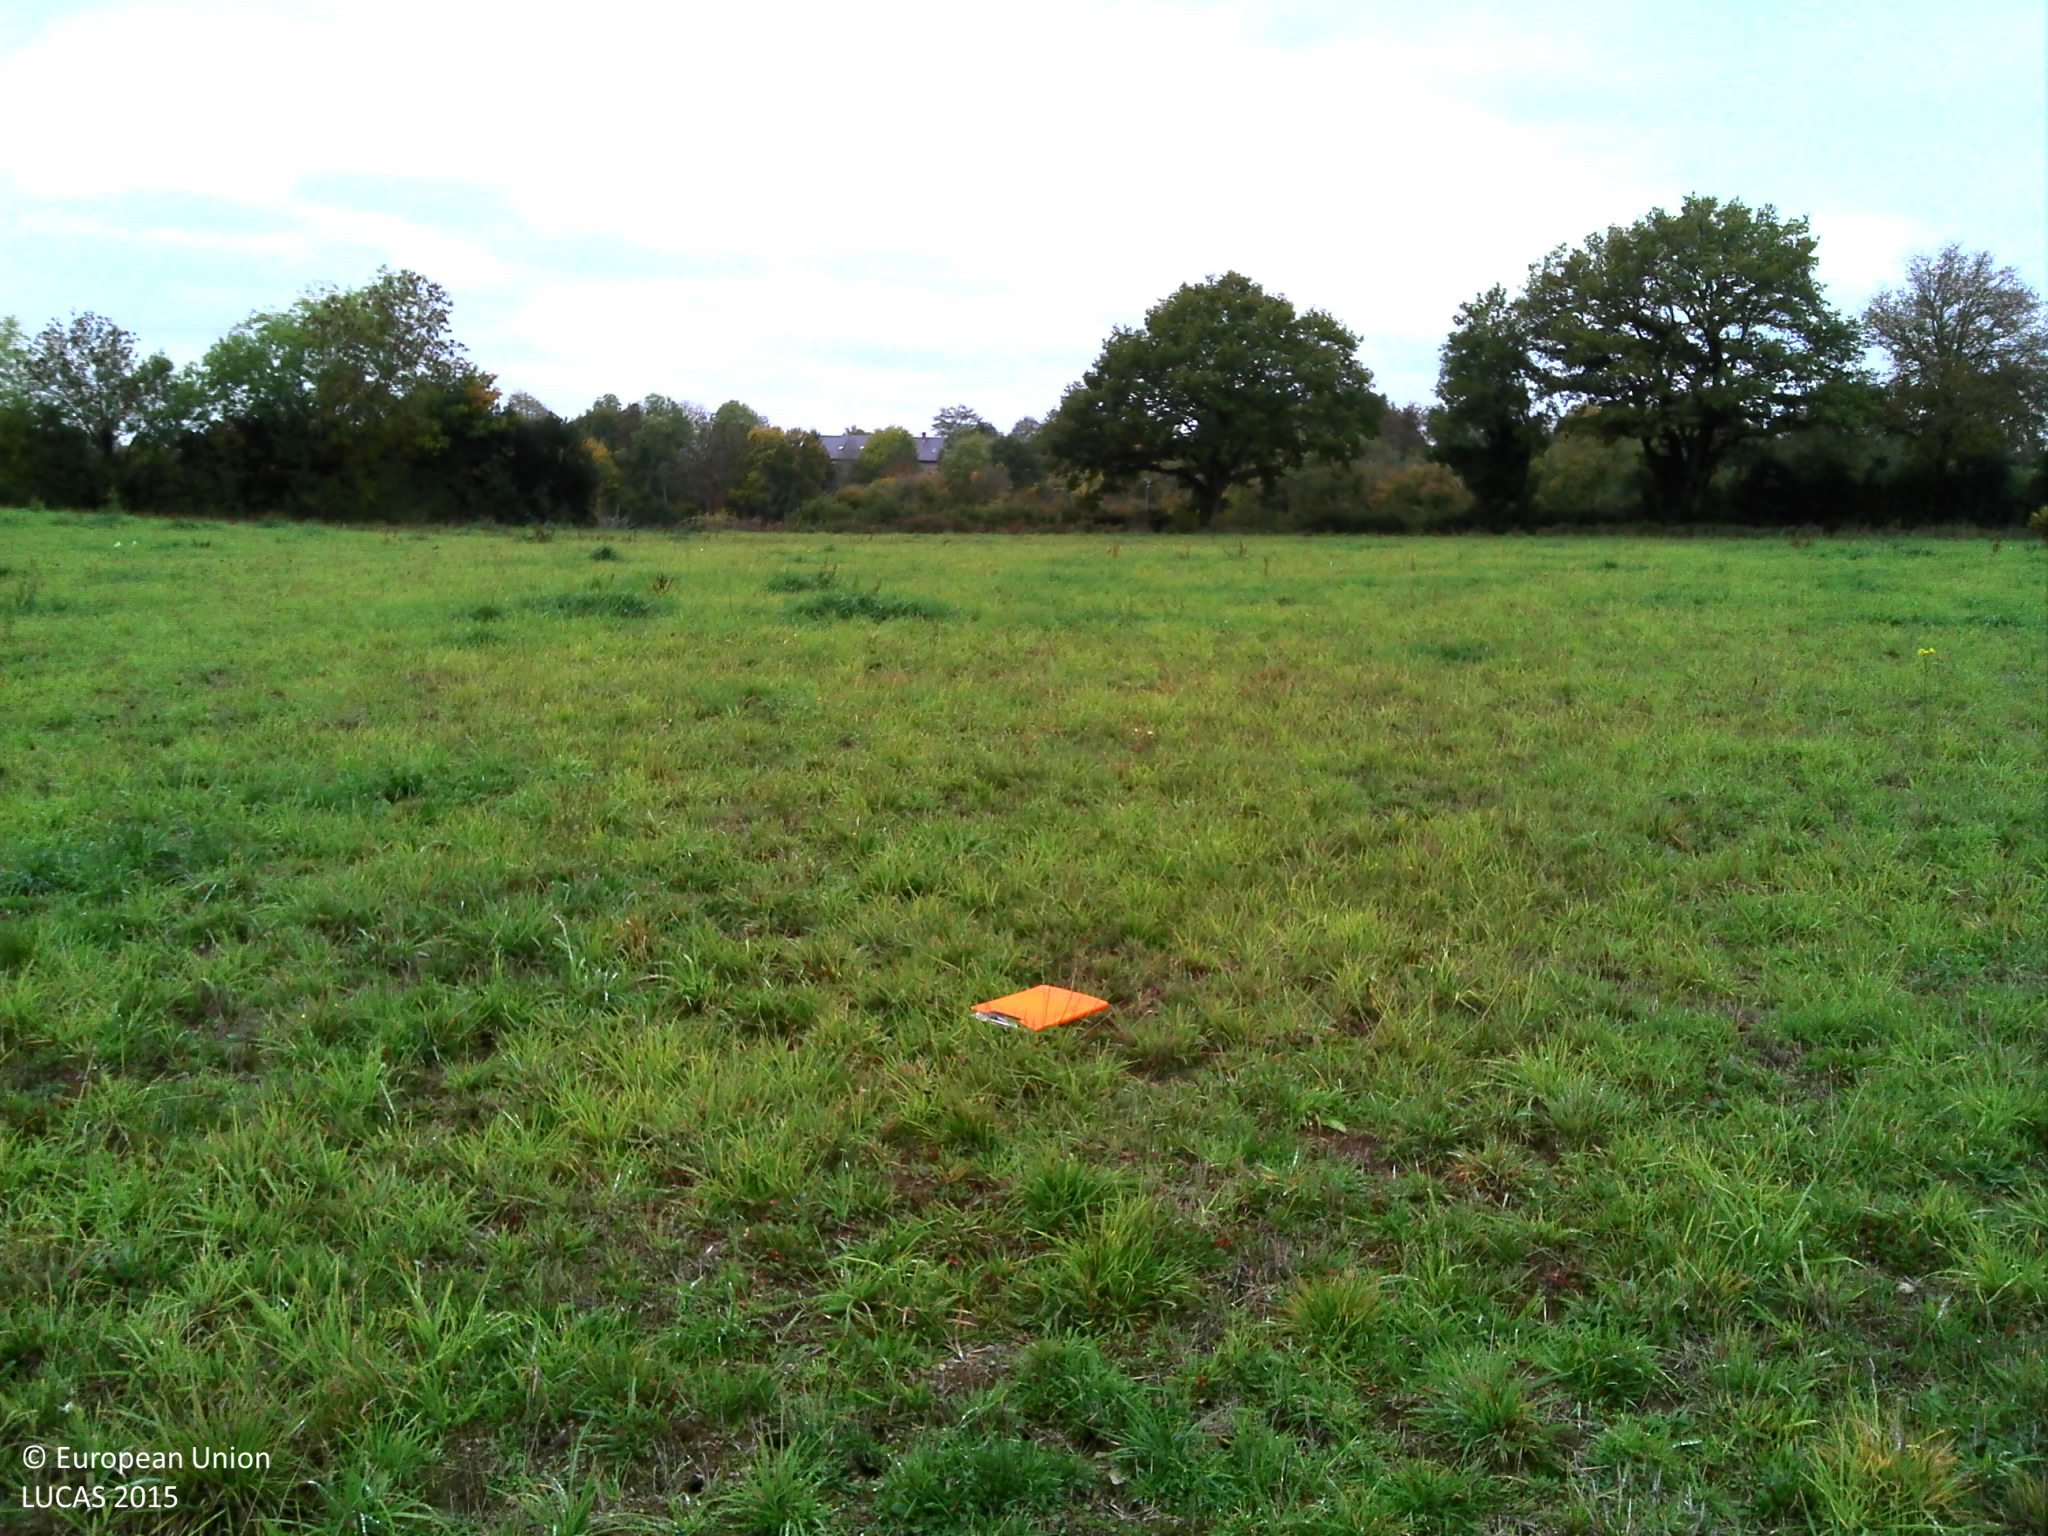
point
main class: Grassland
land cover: Grassland without tree/shrub cover
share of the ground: > 75 %
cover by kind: herbaceous plants 95 %, unconsolidated bare surface 5 %
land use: Agriculture (excluding fallow land and kitchen gardens)
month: October
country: FR
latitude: 46.0020
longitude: 2.8314
